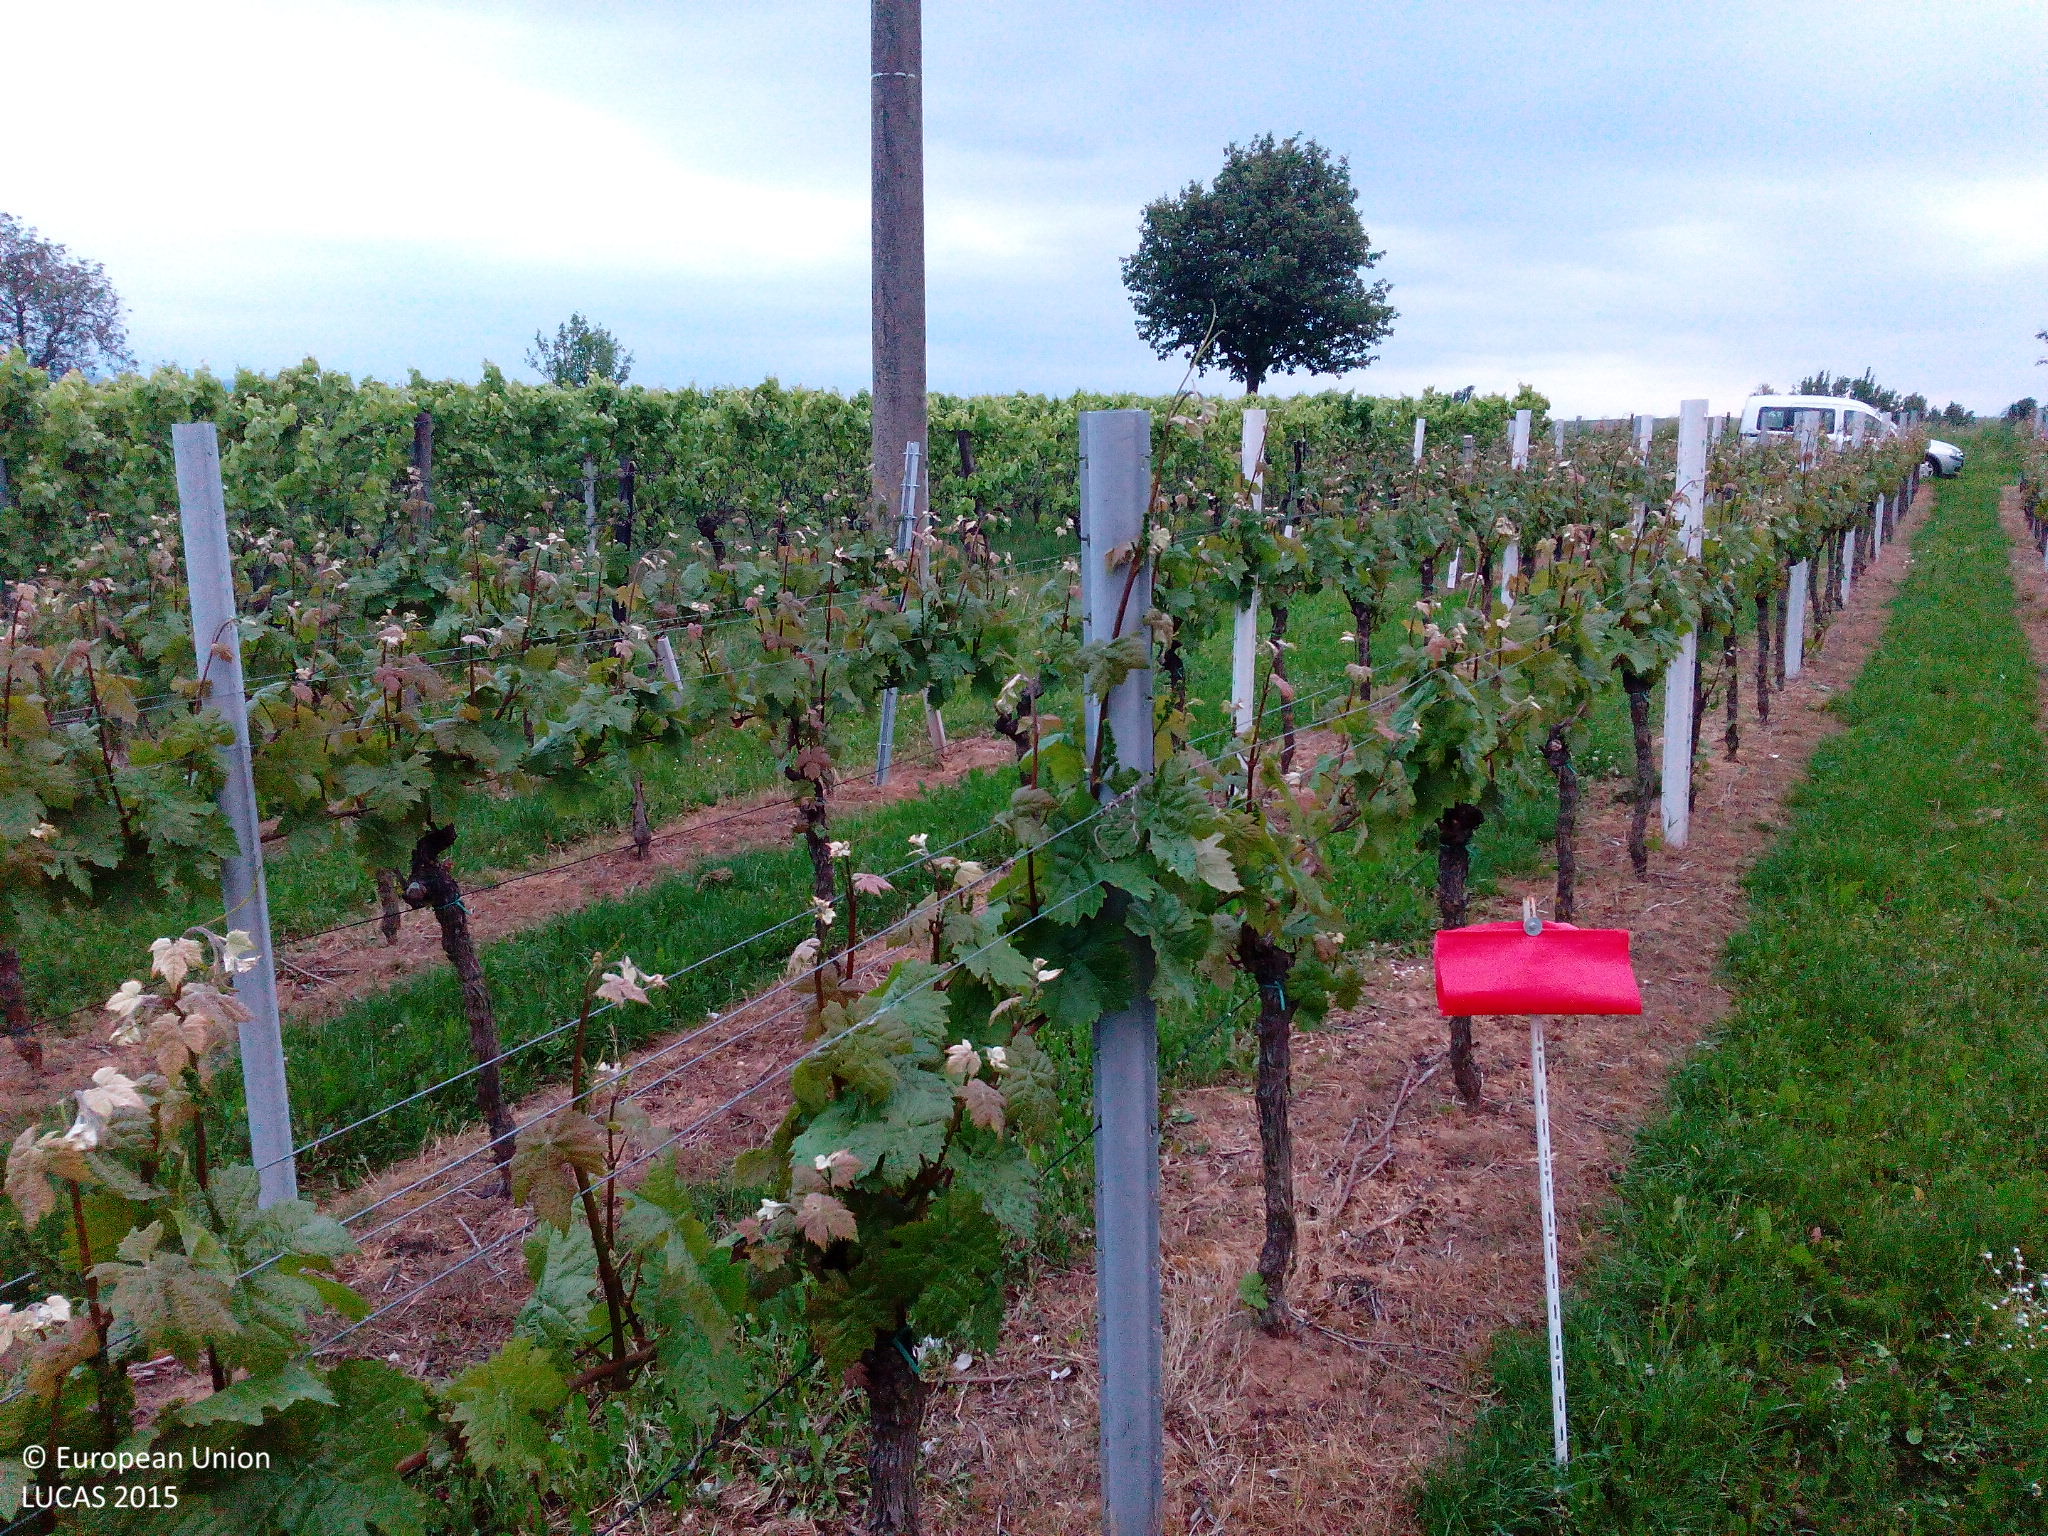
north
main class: Cropland
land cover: Vineyards
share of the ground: 25 - 50 %
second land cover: Grassland without tree/shrub cover
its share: 25 - 50 %
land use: Agriculture (excluding fallow land and kitchen gardens)
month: May
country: DE
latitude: 49.1424
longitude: 8.0678
